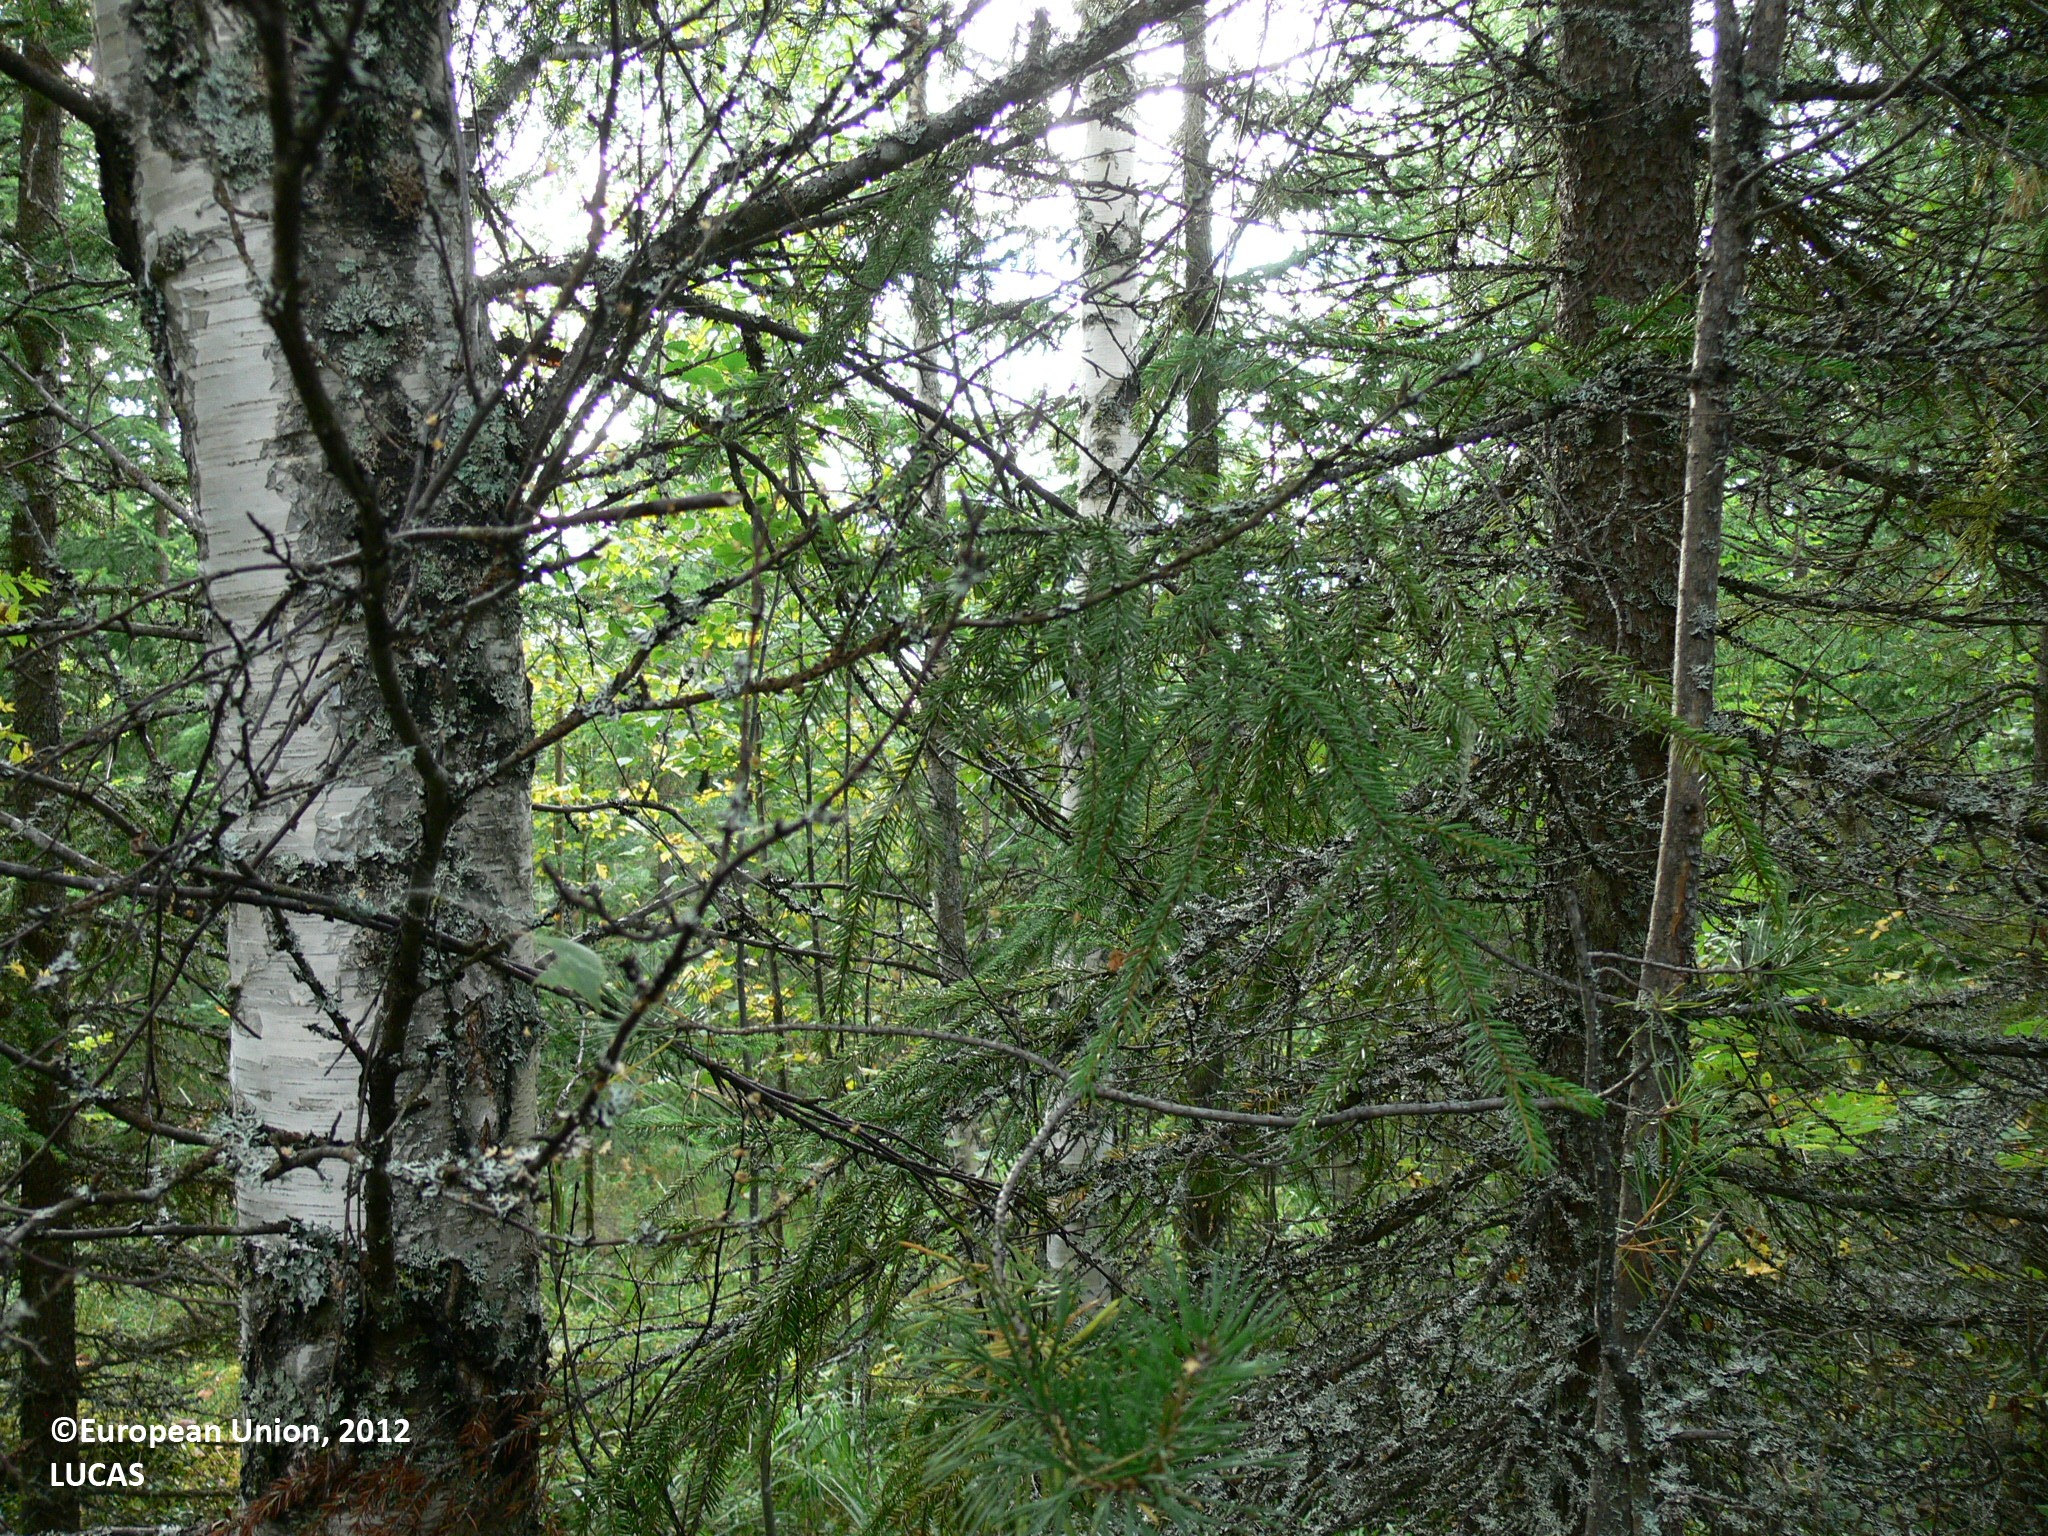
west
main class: Woodland
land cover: Spruce dominated mixed woodland
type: boreal forest
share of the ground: > 75 %
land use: Forestry
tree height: > 5 m
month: August
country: FI
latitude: 63.3512
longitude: 30.0981
